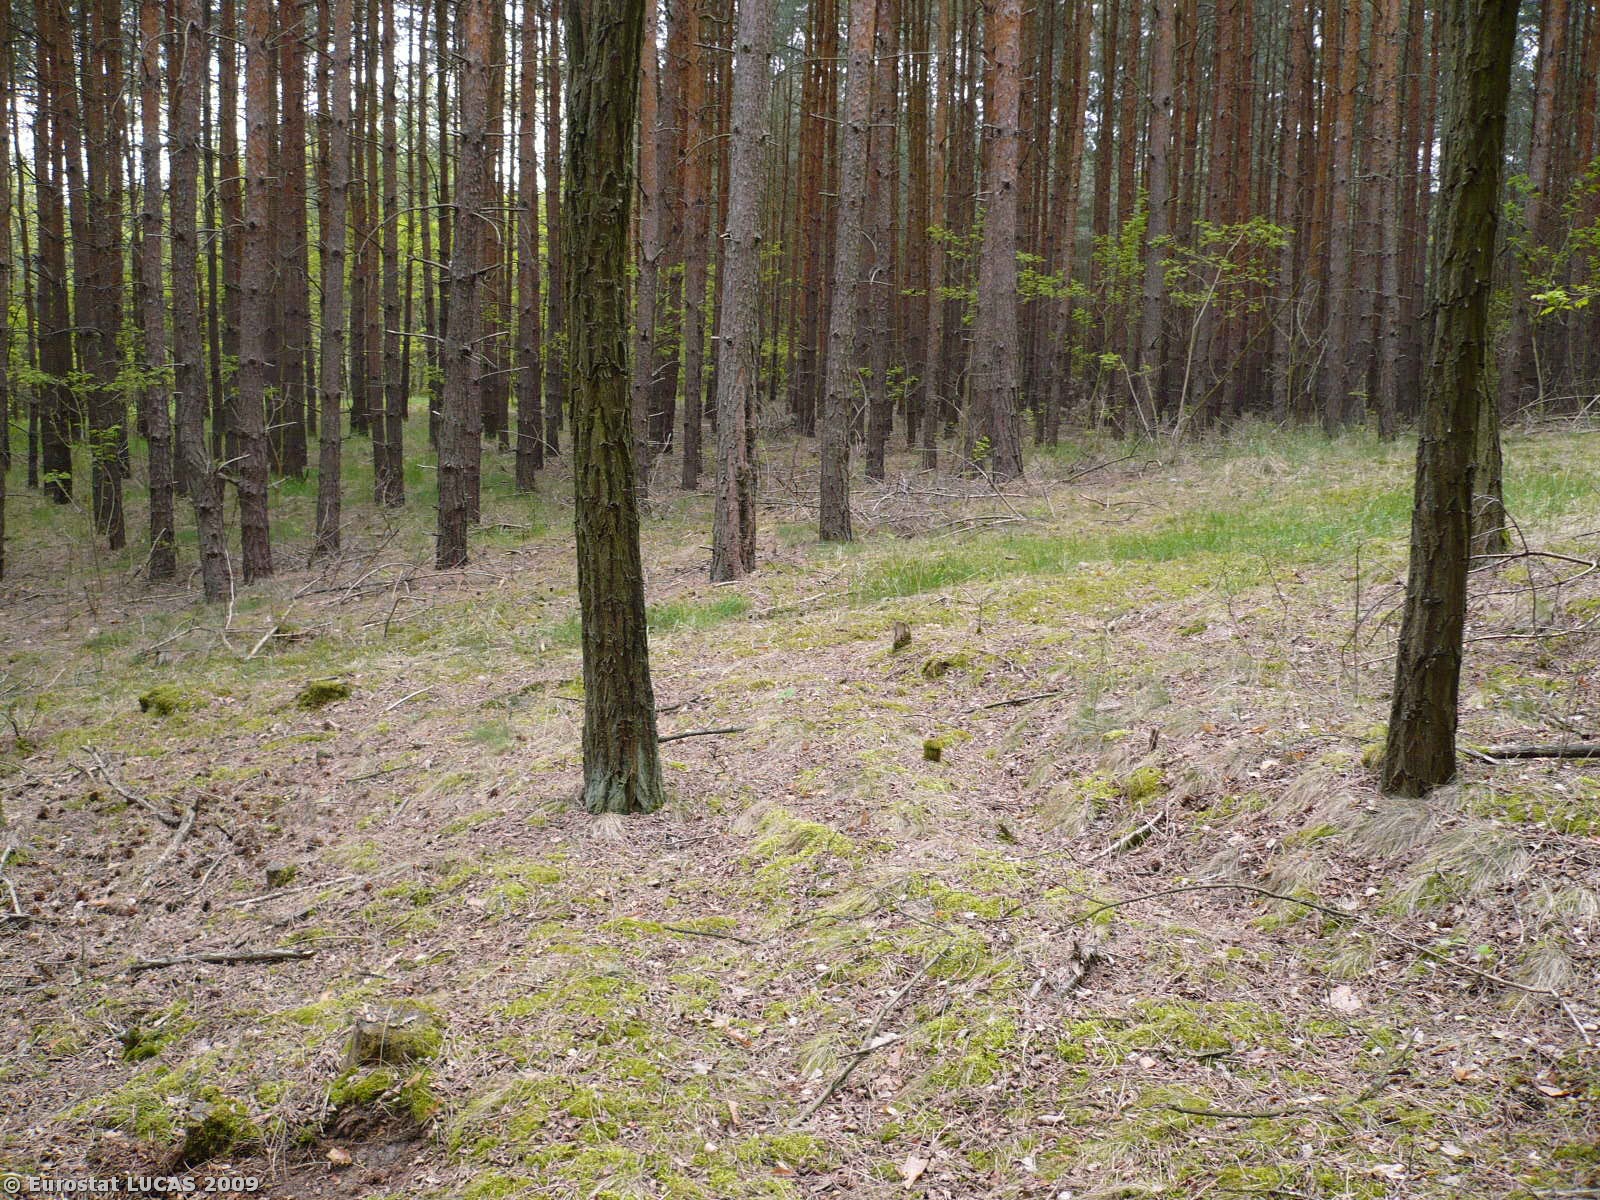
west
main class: Woodland
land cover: Coniferous woodland
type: hemiboreal forest and nemoral coniferous forest and mixed broadleaved-coniferous forest
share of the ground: > 75 %
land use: Forestry
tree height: > 5 m
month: May
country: PL
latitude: 52.0614
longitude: 15.6785
